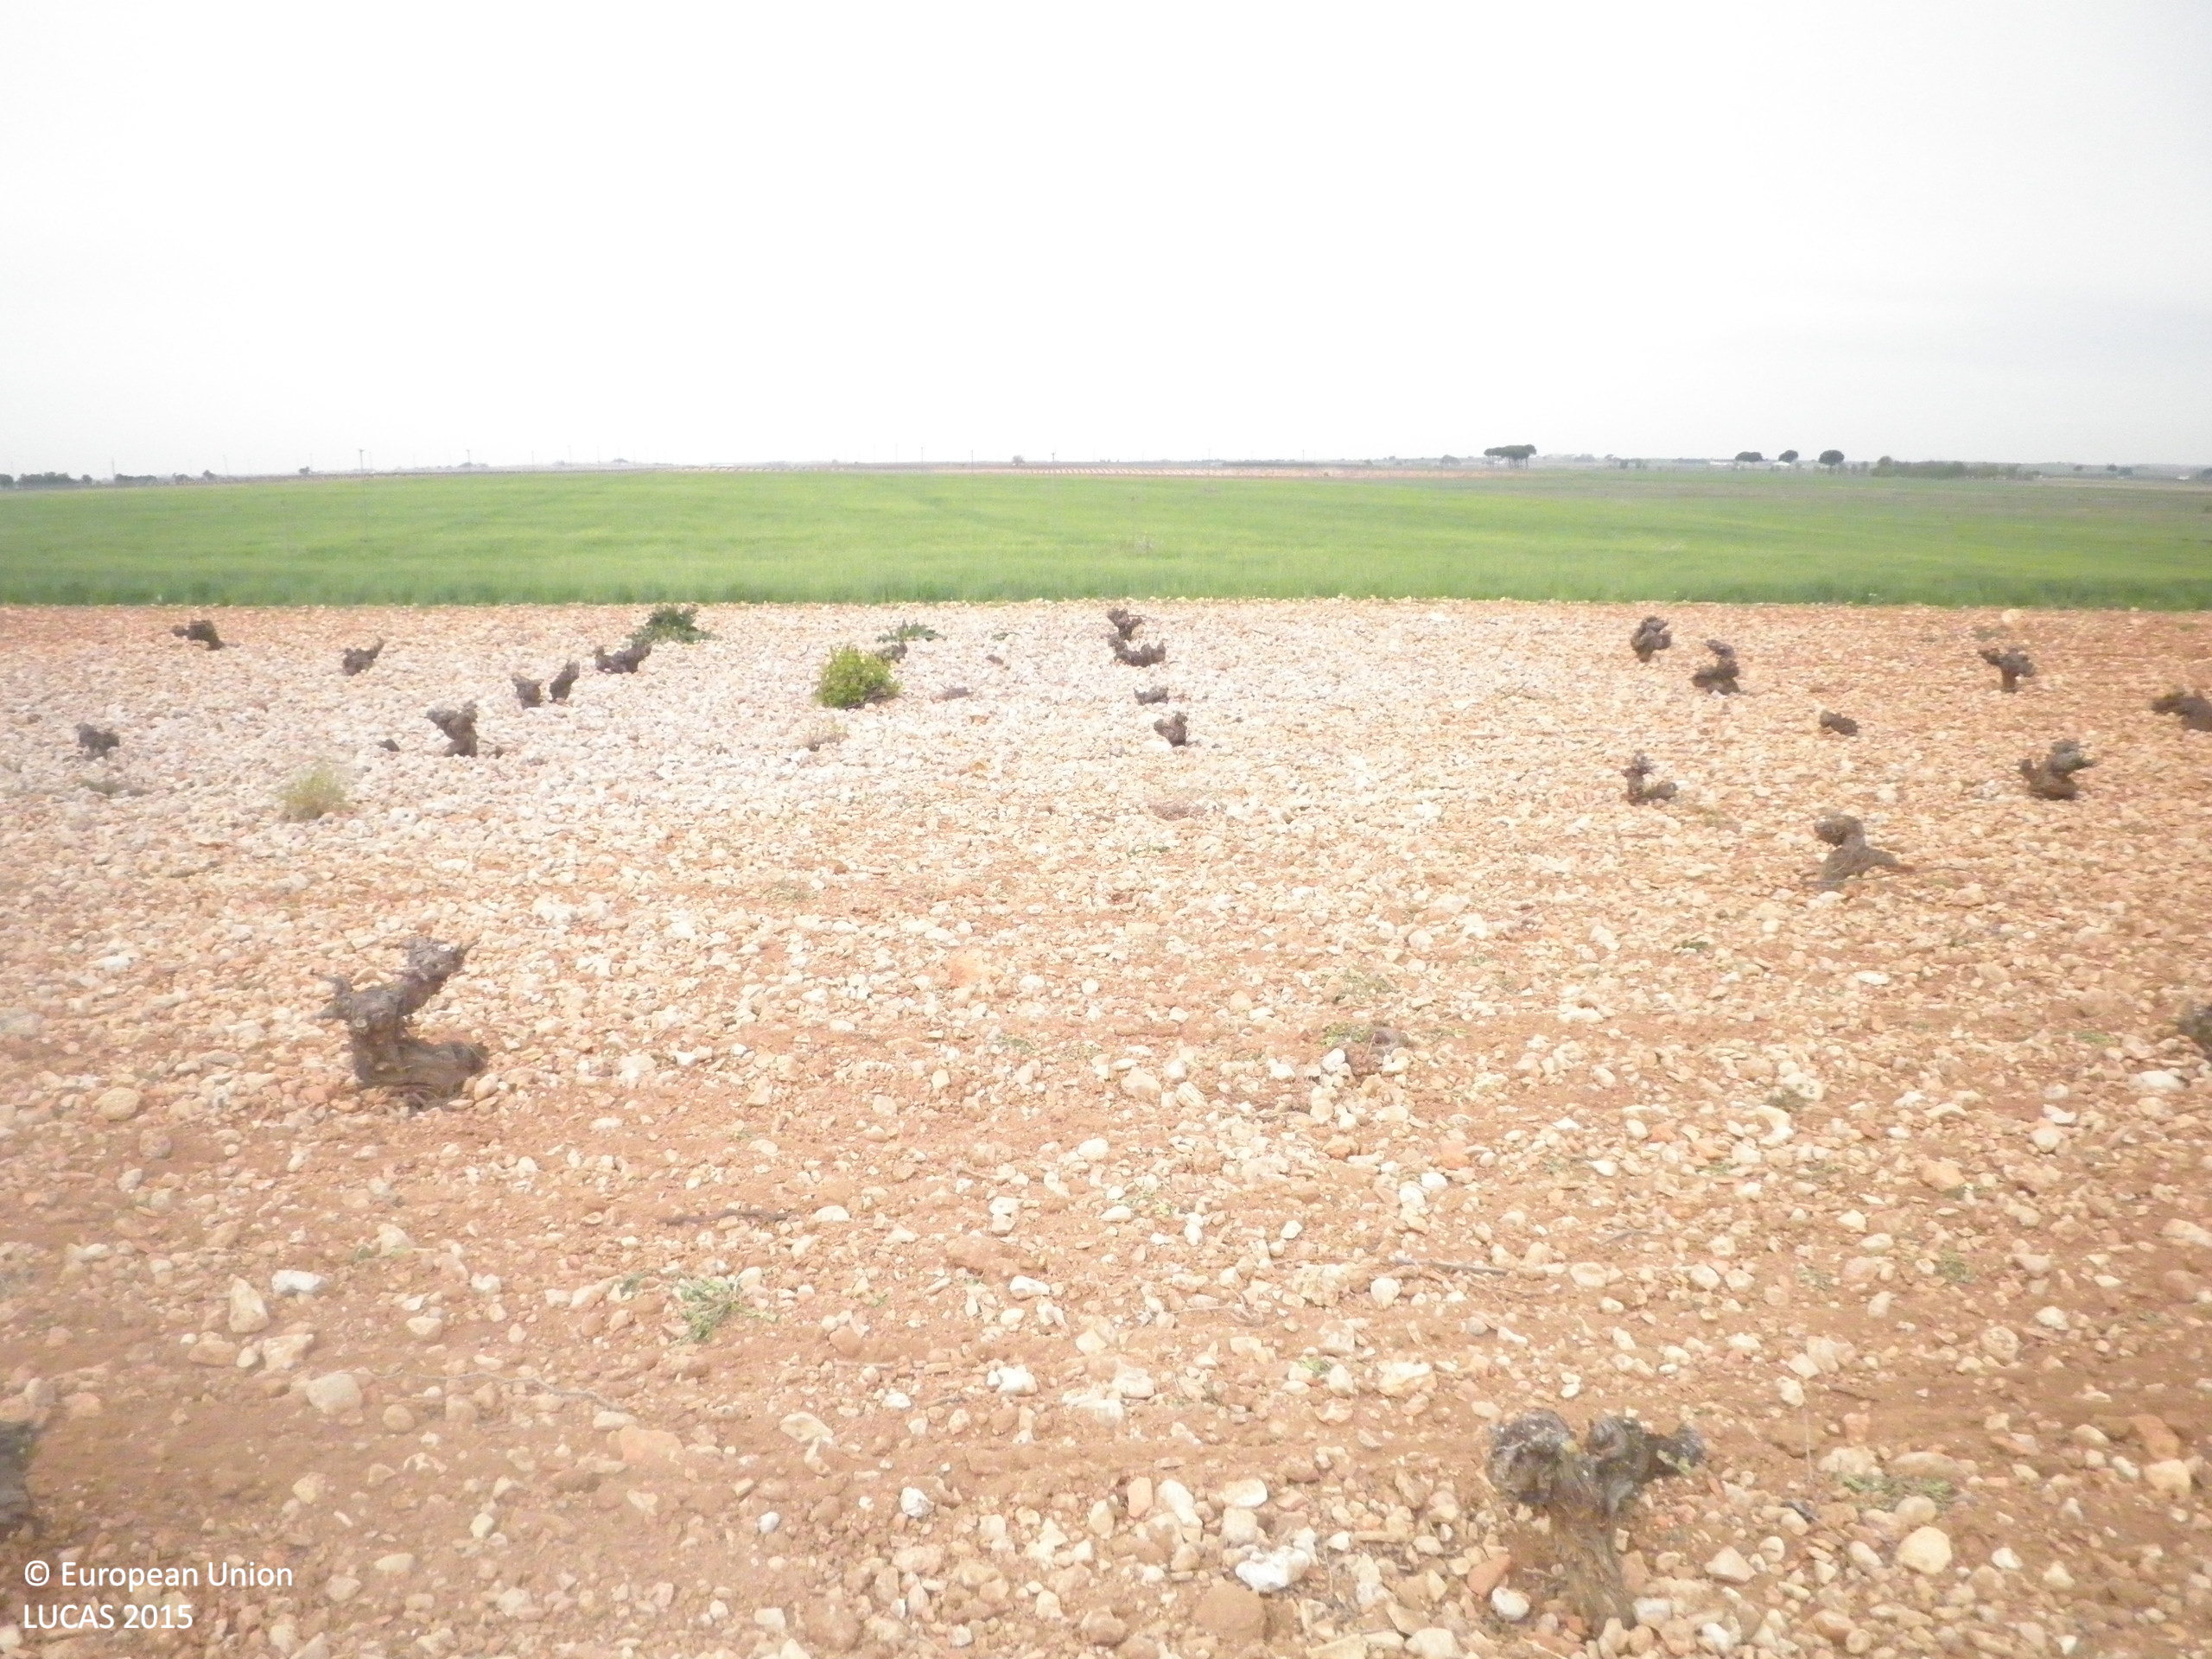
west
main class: Cropland
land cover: Vineyards
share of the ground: < 10 %
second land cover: Other bare soil
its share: > 75 %
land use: Agriculture (excluding fallow land and kitchen gardens)
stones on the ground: > 50 %
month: April
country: ES
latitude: 39.4011
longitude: -2.7053
